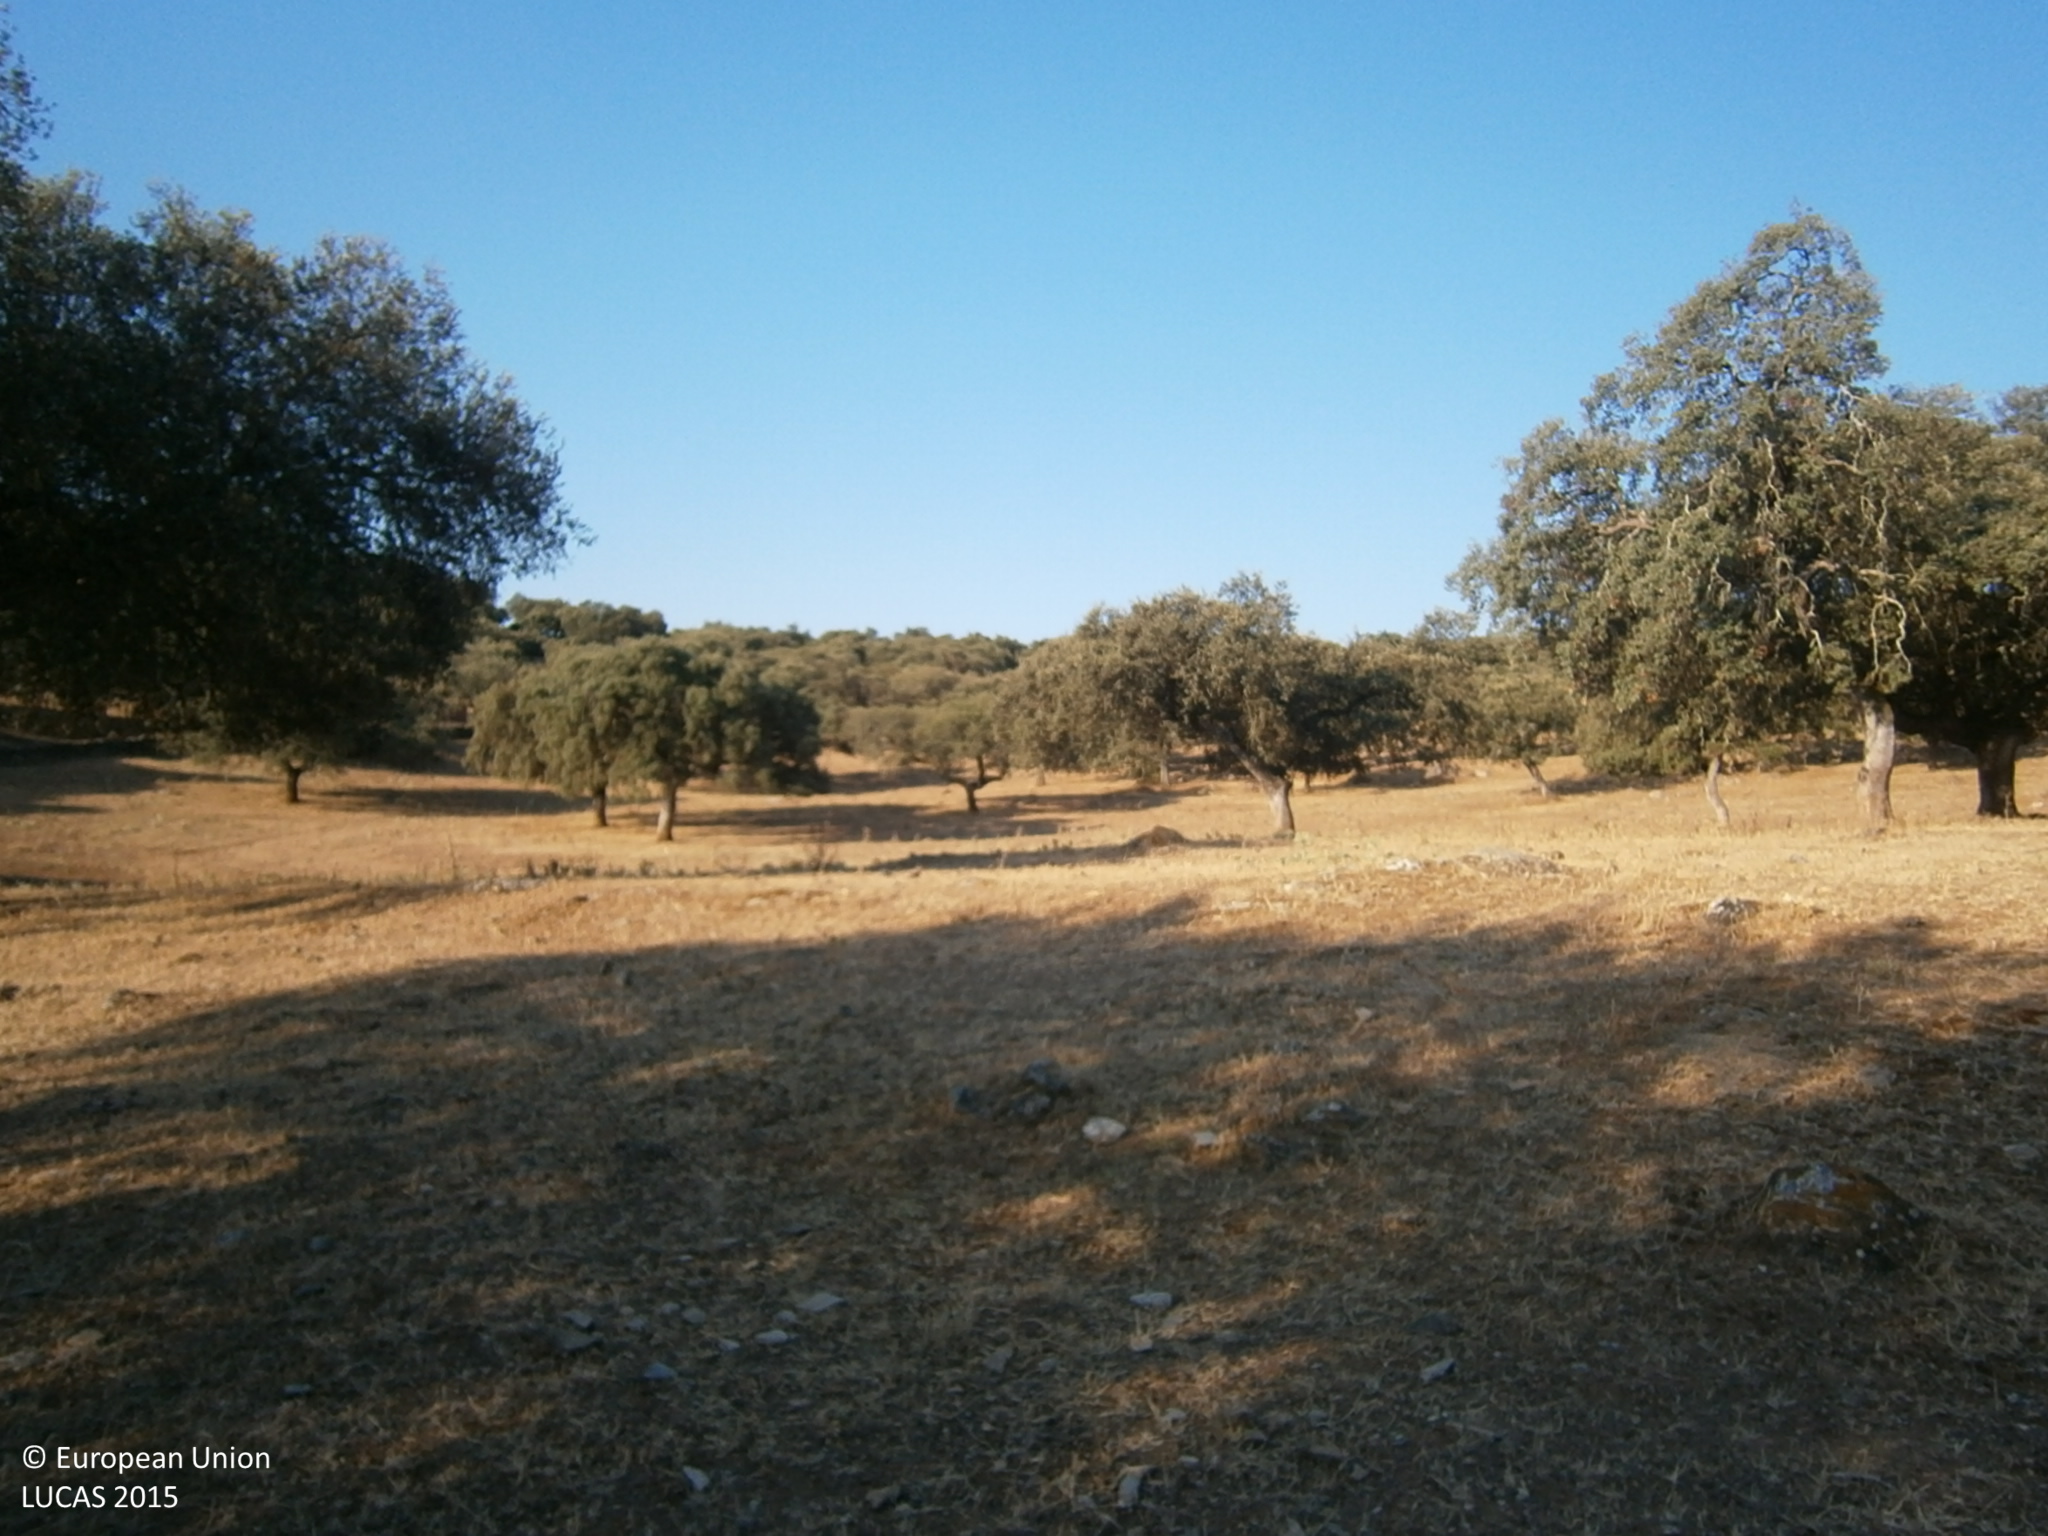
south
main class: Woodland
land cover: Broadleaved woodland
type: broadleaved evergreen forest
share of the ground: > 75 %
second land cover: Spontaneously vegetated surfaces
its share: 50 - 75 %
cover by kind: herbaceous plants 70 %, broadleaved forest trees 10 %, unconsolidated bare surface 10 %, shrubs 5 %
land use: Forestry
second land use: Agriculture (excluding fallow land and kitchen gardens)
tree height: > 5 m
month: June
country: ES
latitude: 38.5839
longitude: -6.8100
